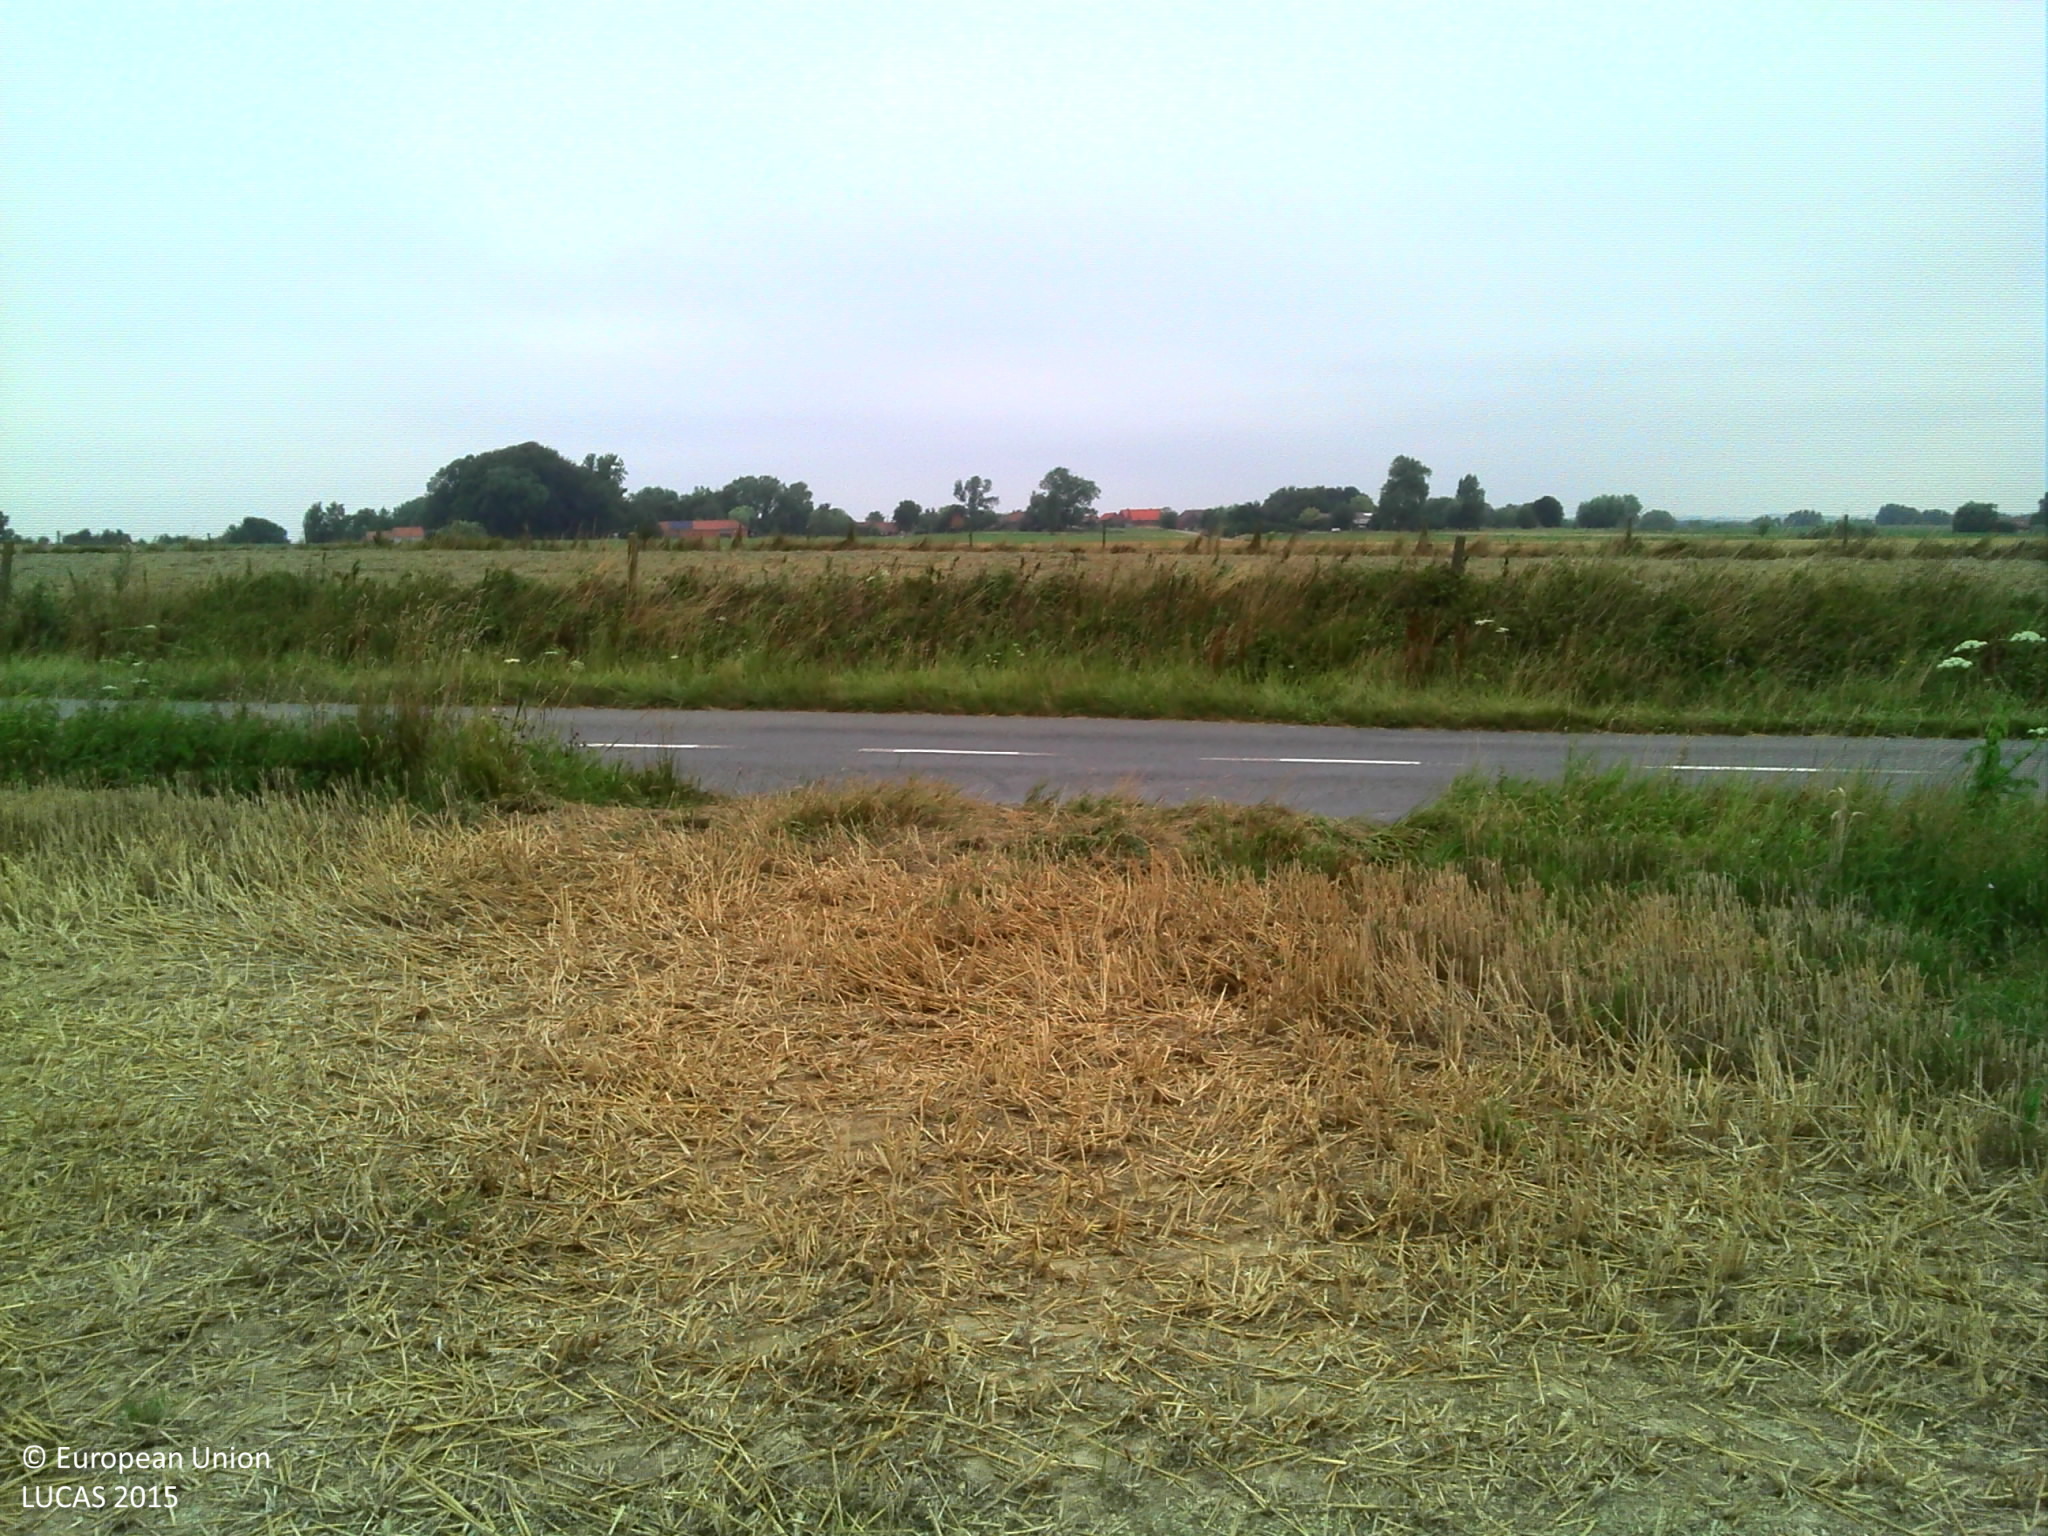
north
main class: Cropland
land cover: Common wheat
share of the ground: > 75 %
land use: Agriculture (excluding fallow land and kitchen gardens)
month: August
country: BE
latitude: 50.6981
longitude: 3.7497
